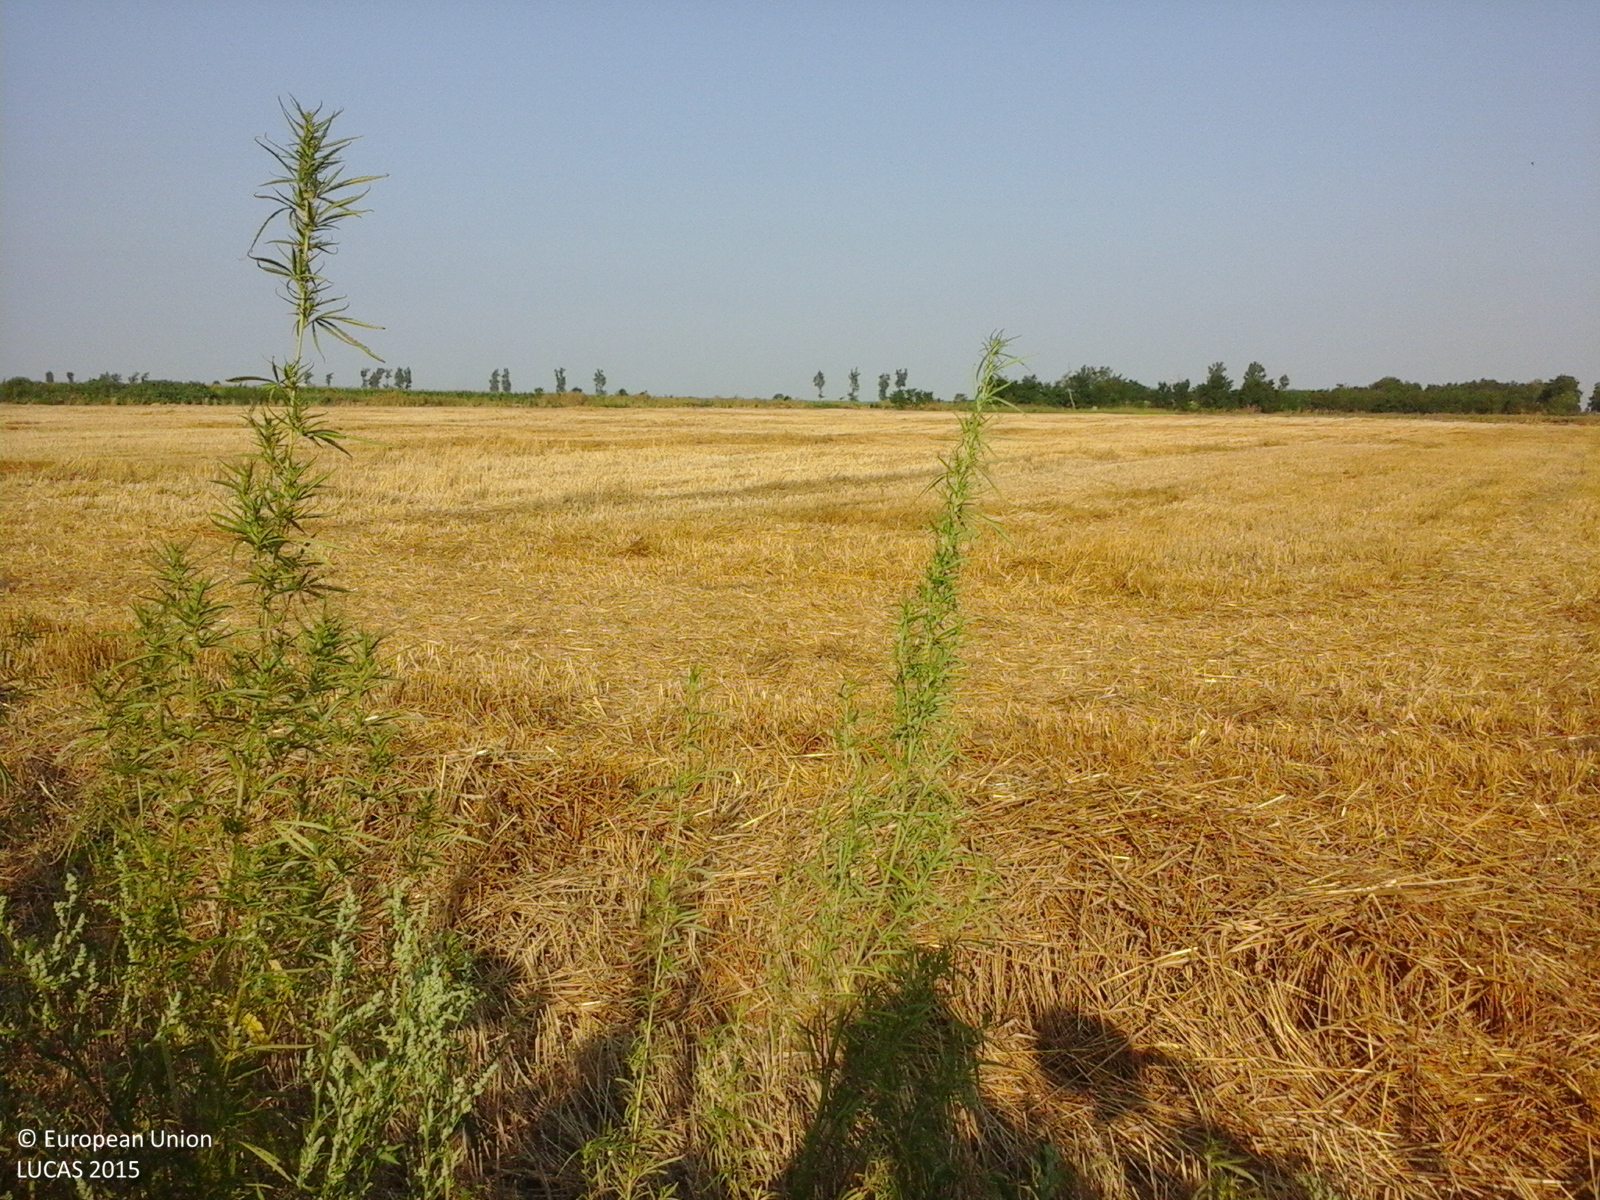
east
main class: Cropland
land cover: Sunflower
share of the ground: > 75 %
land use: Agriculture (excluding fallow land and kitchen gardens)
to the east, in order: Sunflower; Shruby margins; Common wheat; Tracks; Spontaneously vegetated surfaces
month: July
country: RO
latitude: 44.7738
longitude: 27.3392
